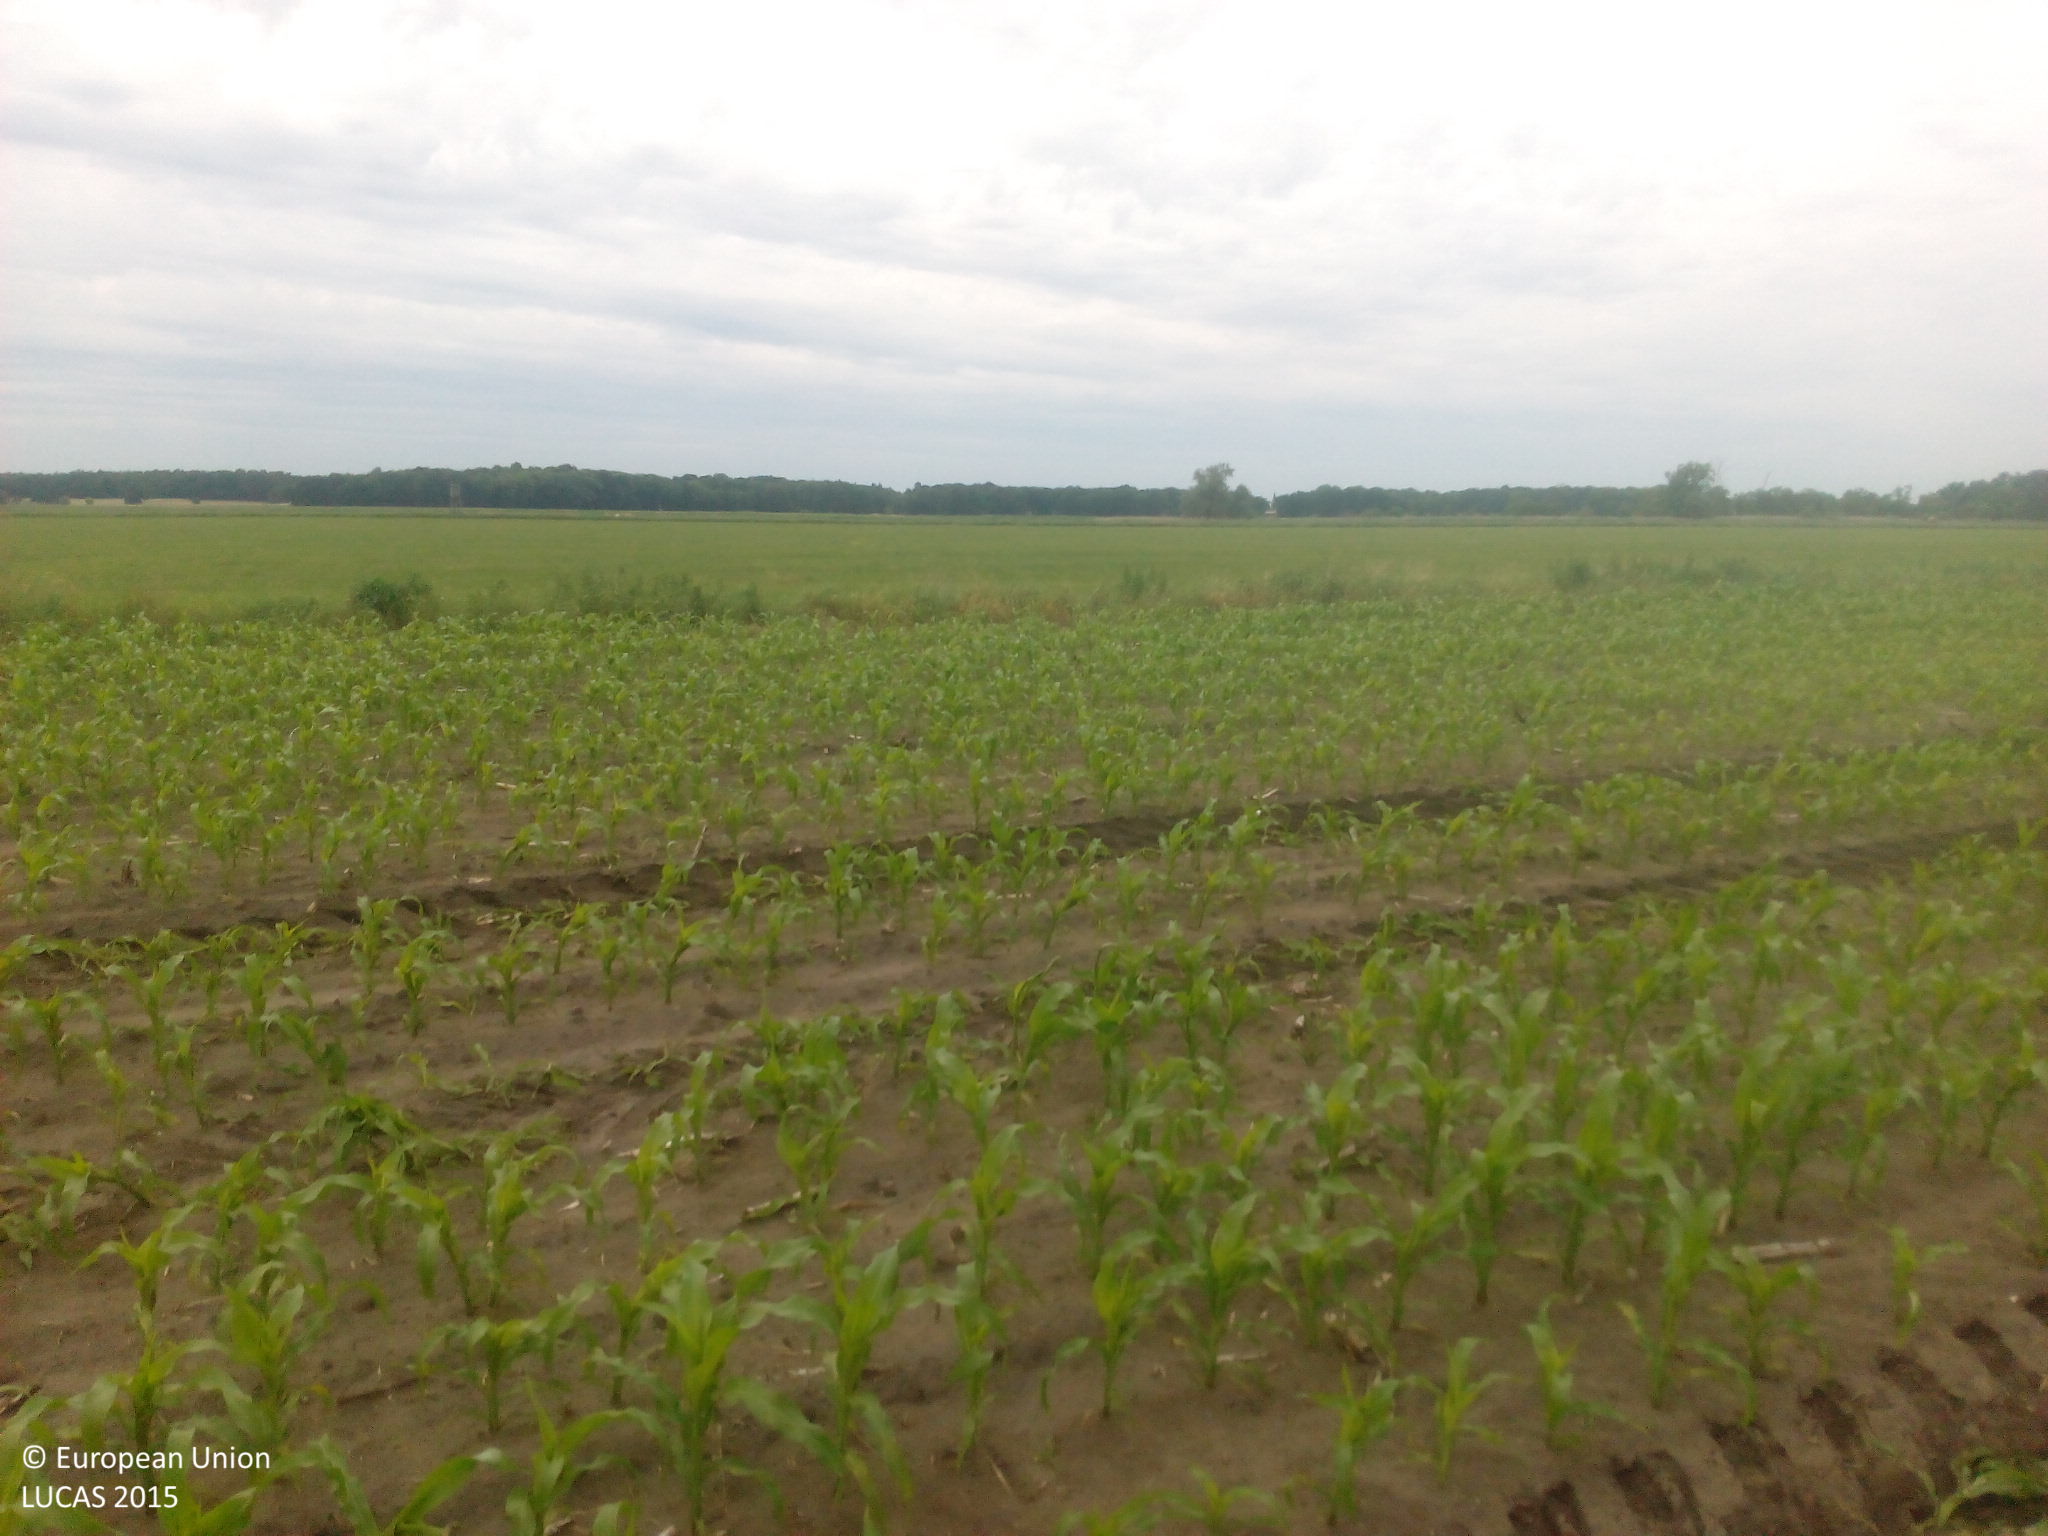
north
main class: Cropland
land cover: Maize
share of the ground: < 10 %
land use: Agriculture (excluding fallow land and kitchen gardens)
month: June
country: DE
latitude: 52.6364
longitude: 12.6151
